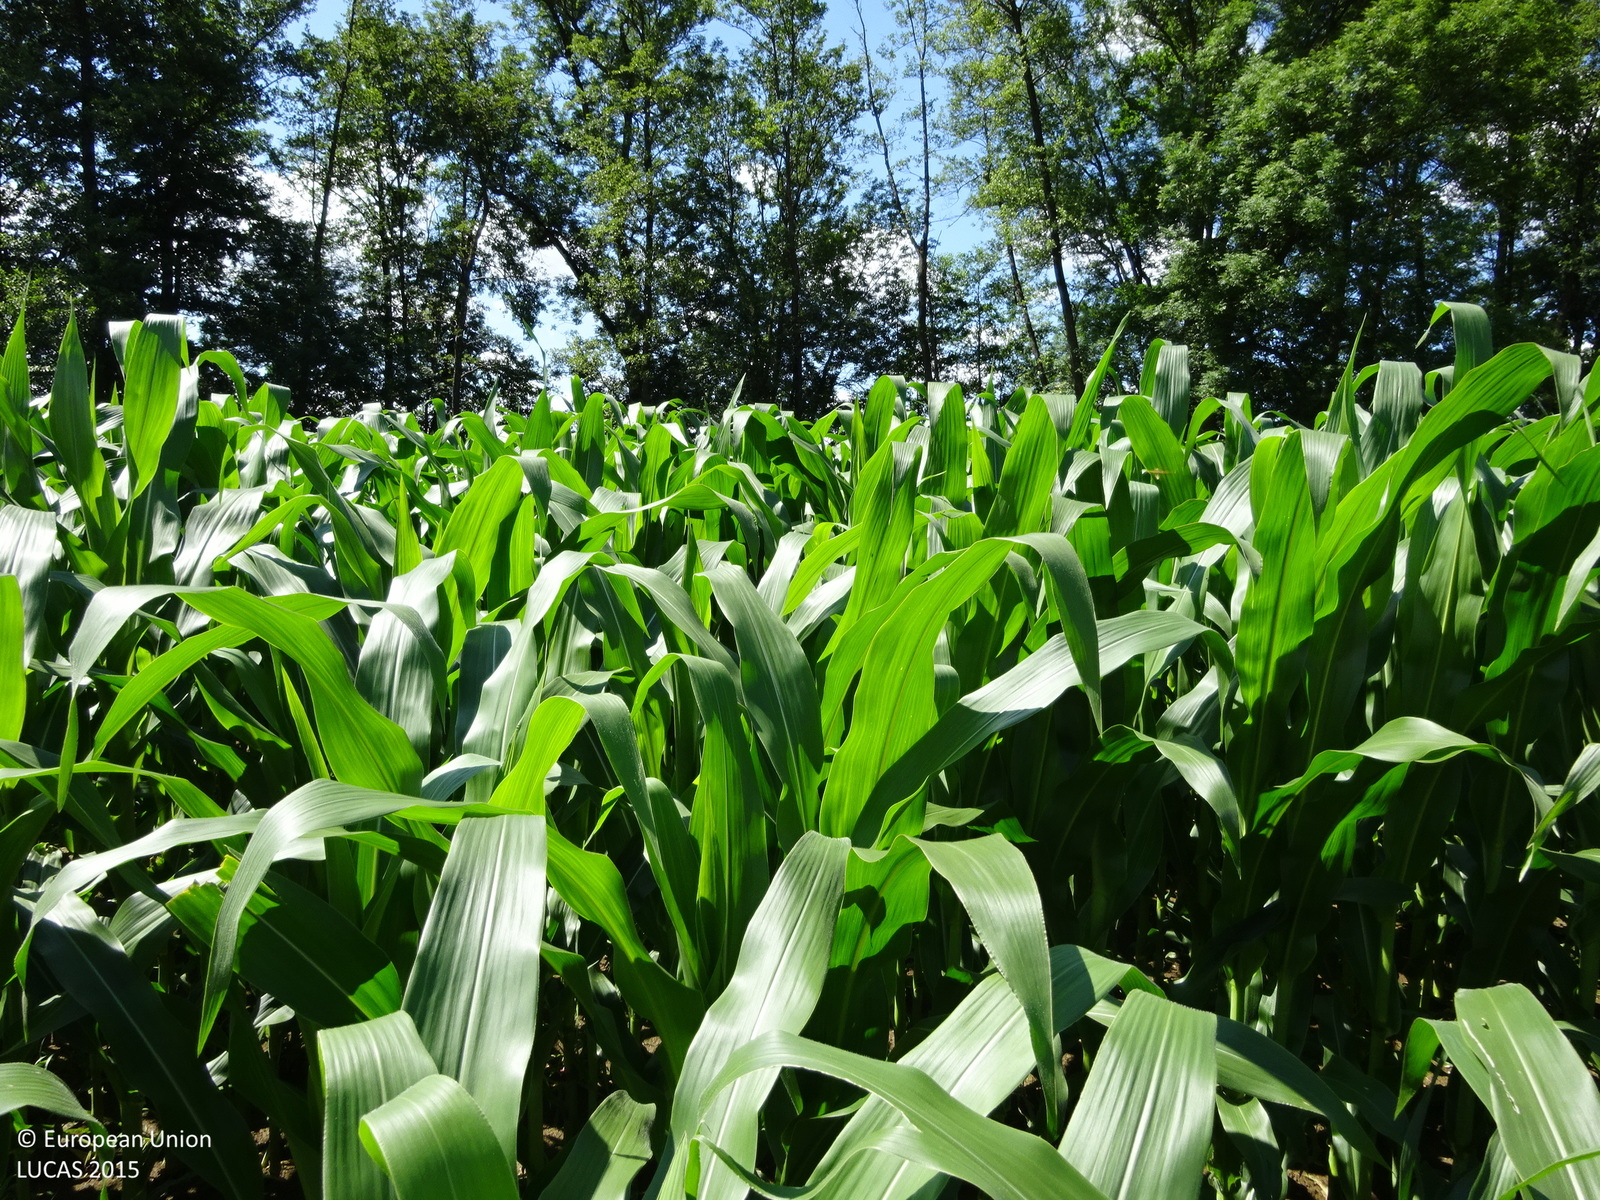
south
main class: Cropland
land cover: Common wheat
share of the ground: > 75 %
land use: Agriculture (excluding fallow land and kitchen gardens)
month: June
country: AT
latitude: 46.7091
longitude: 15.9518
